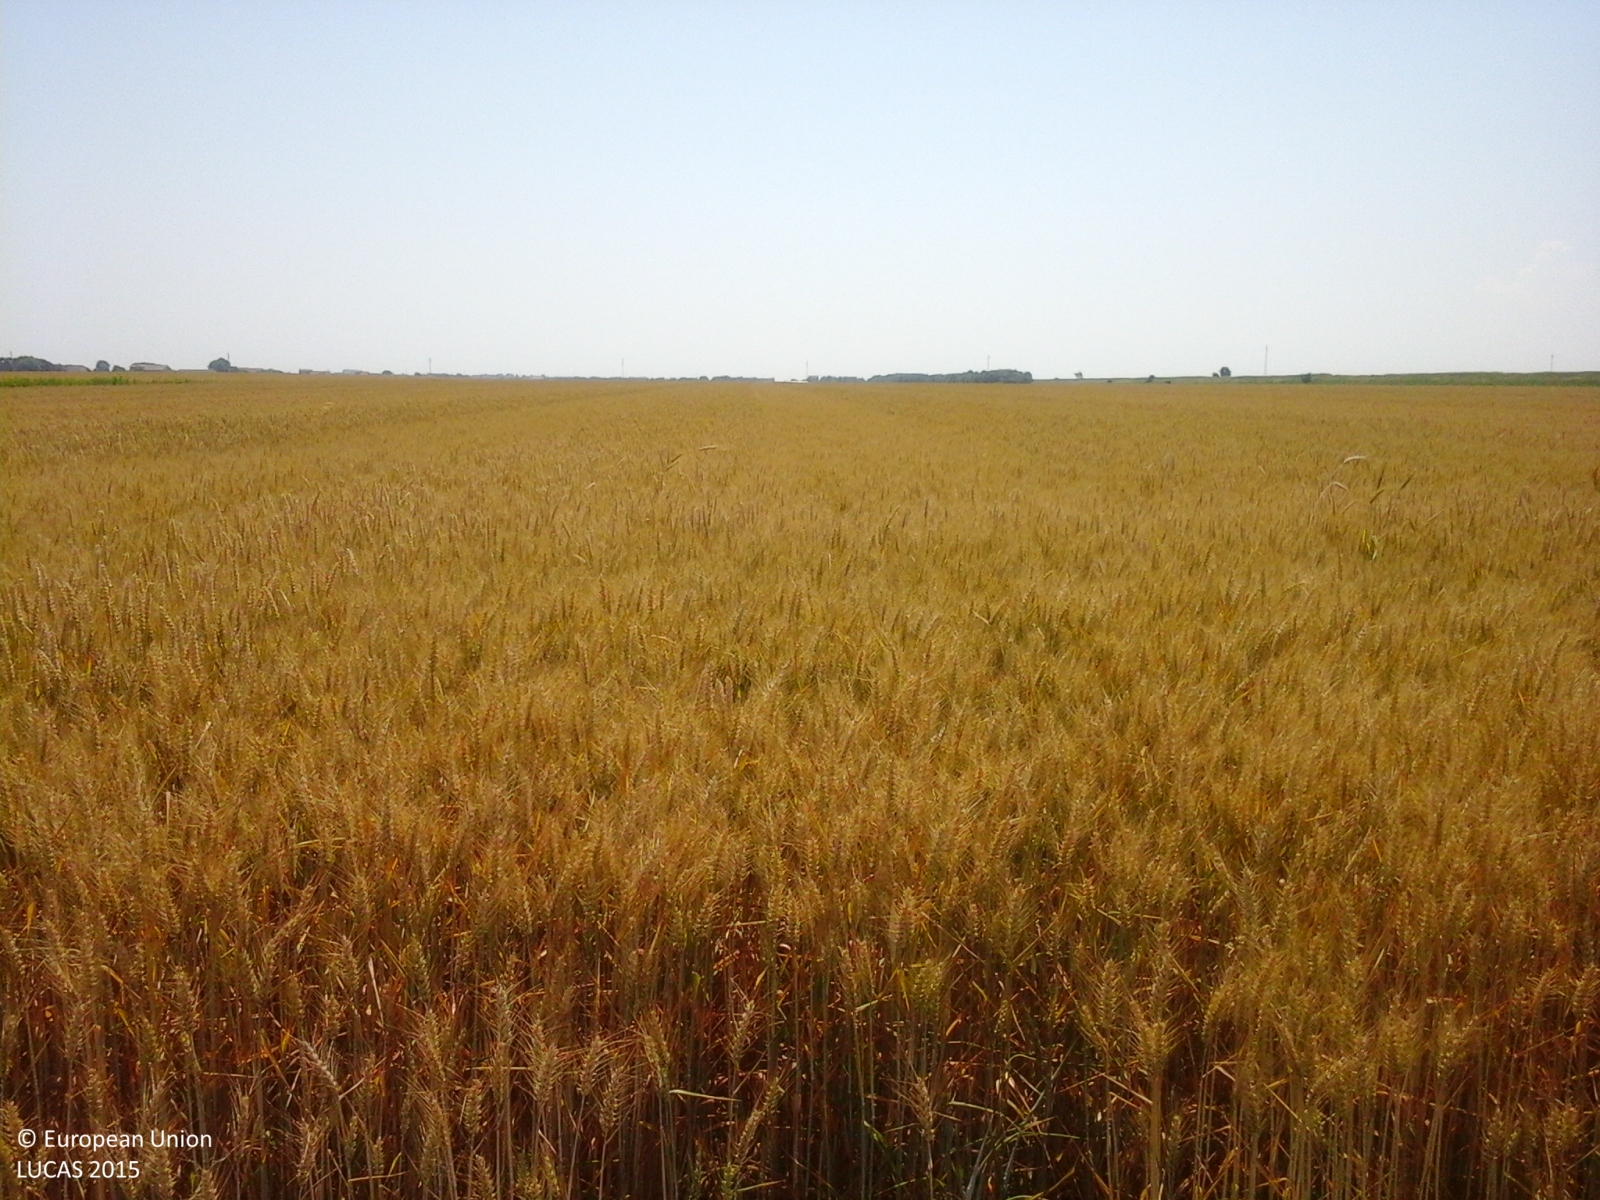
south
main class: Cropland
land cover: Common wheat
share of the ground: > 75 %
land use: Agriculture (excluding fallow land and kitchen gardens)
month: June
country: IT
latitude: 45.6786
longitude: 12.9873
